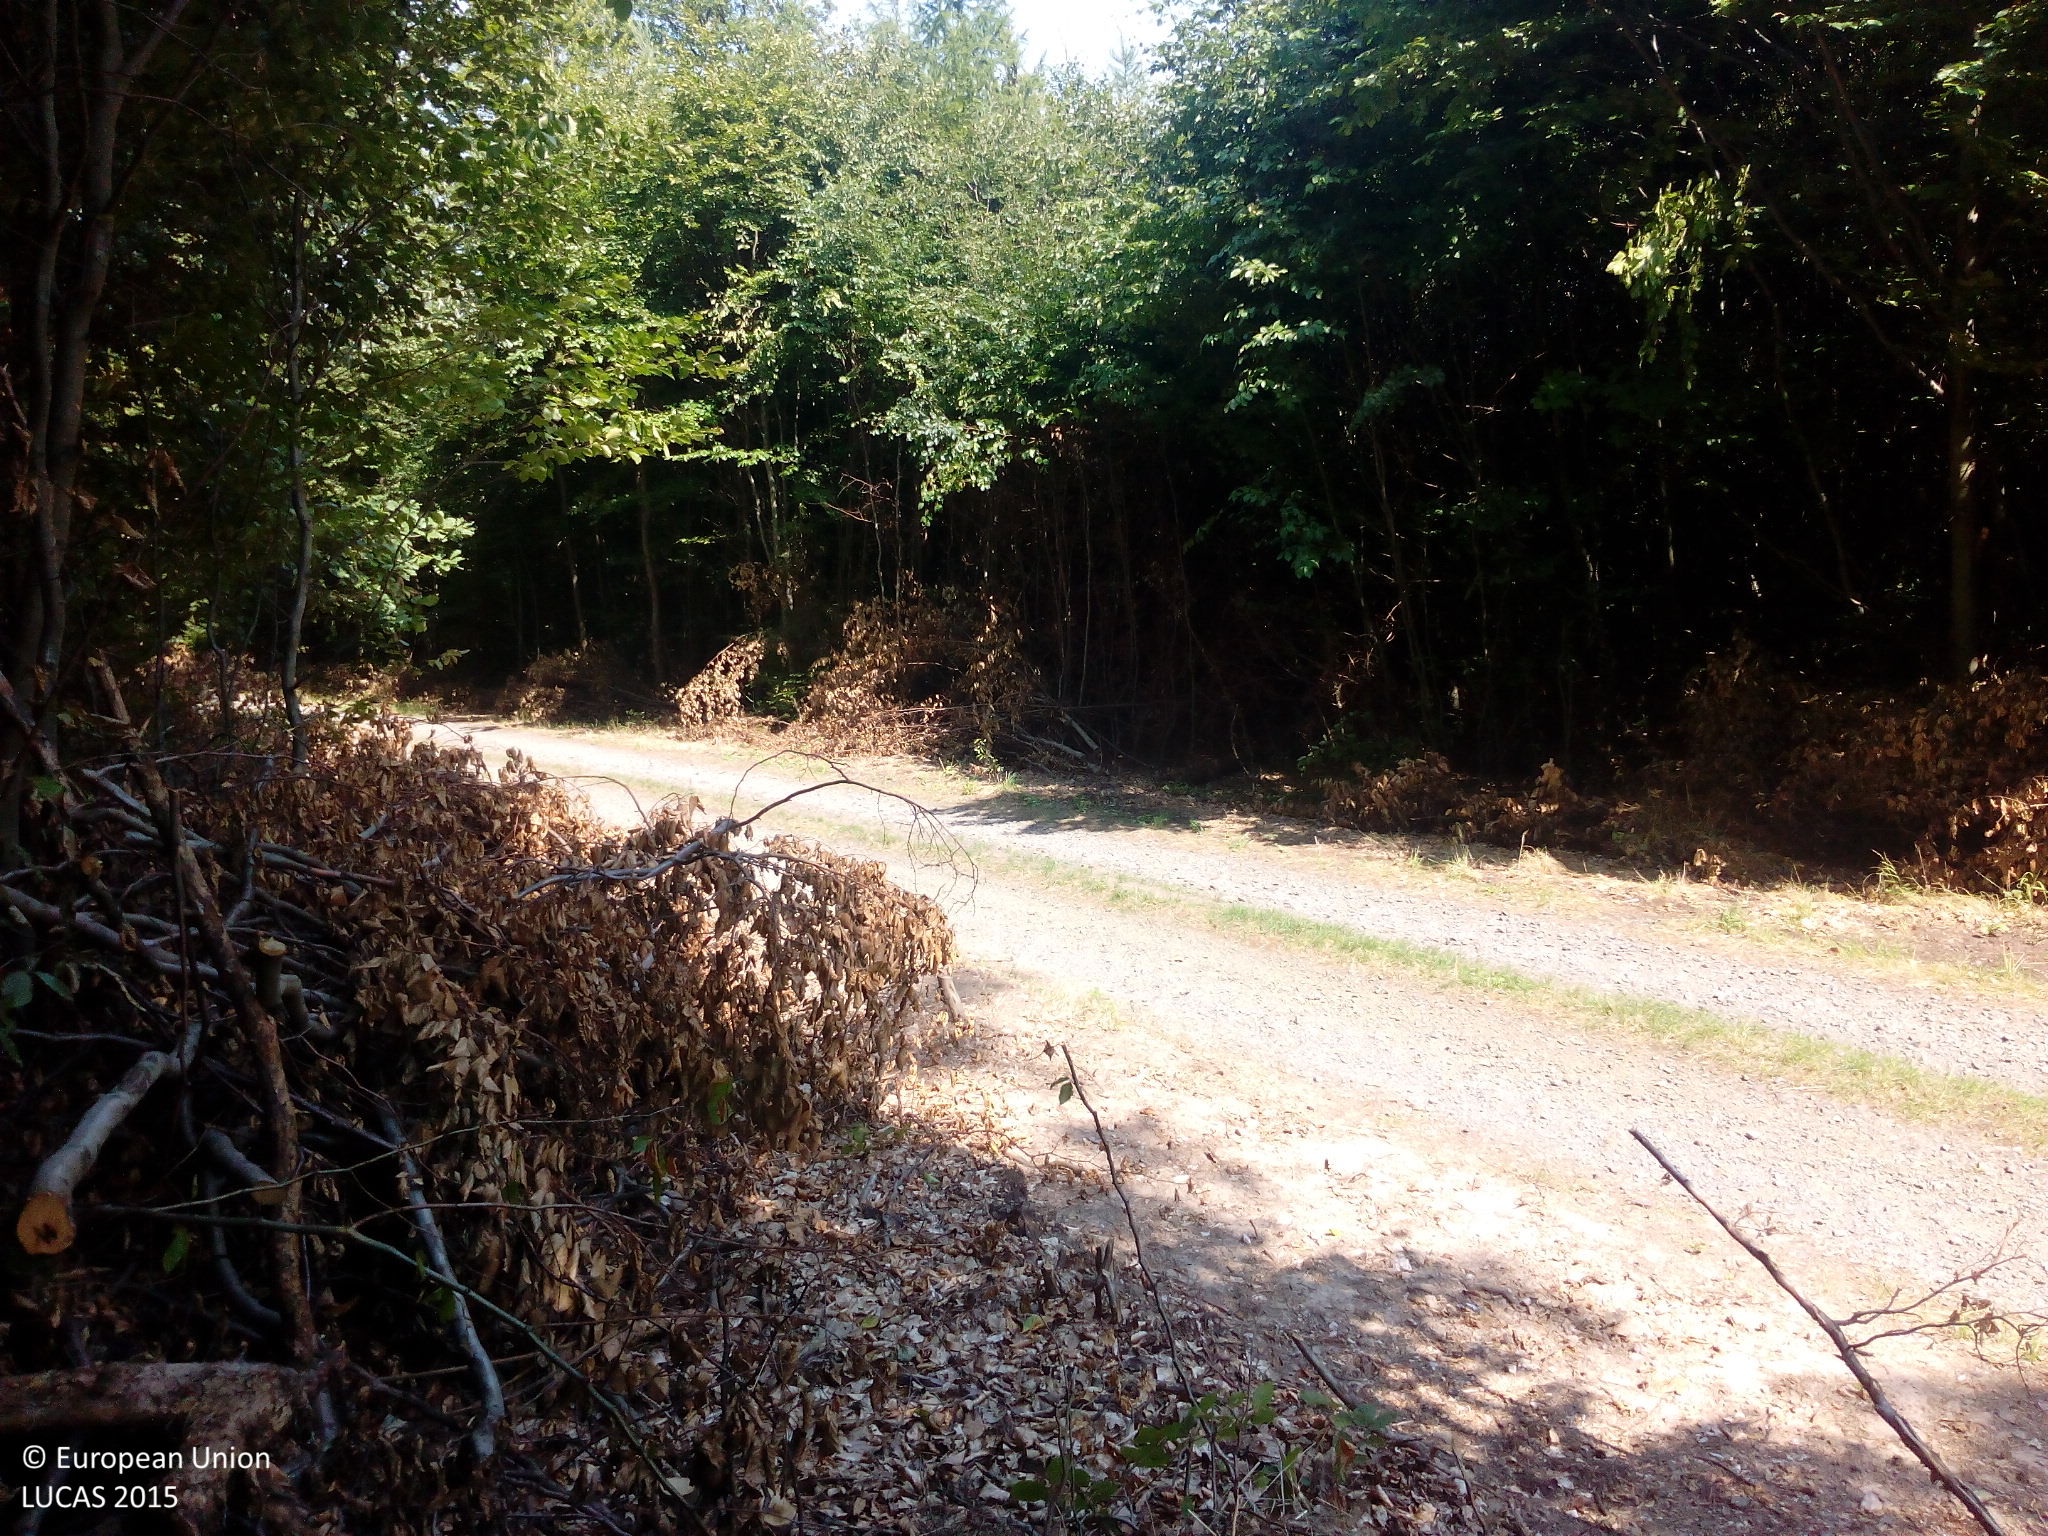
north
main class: Woodland
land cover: Broadleaved woodland
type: beech forest
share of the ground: > 75 %
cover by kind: broadleaved forest trees 90 %, consolidated bare surface 10 %
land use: Forestry
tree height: > 5 m
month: August
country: DE
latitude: 49.7614
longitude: 7.5154
